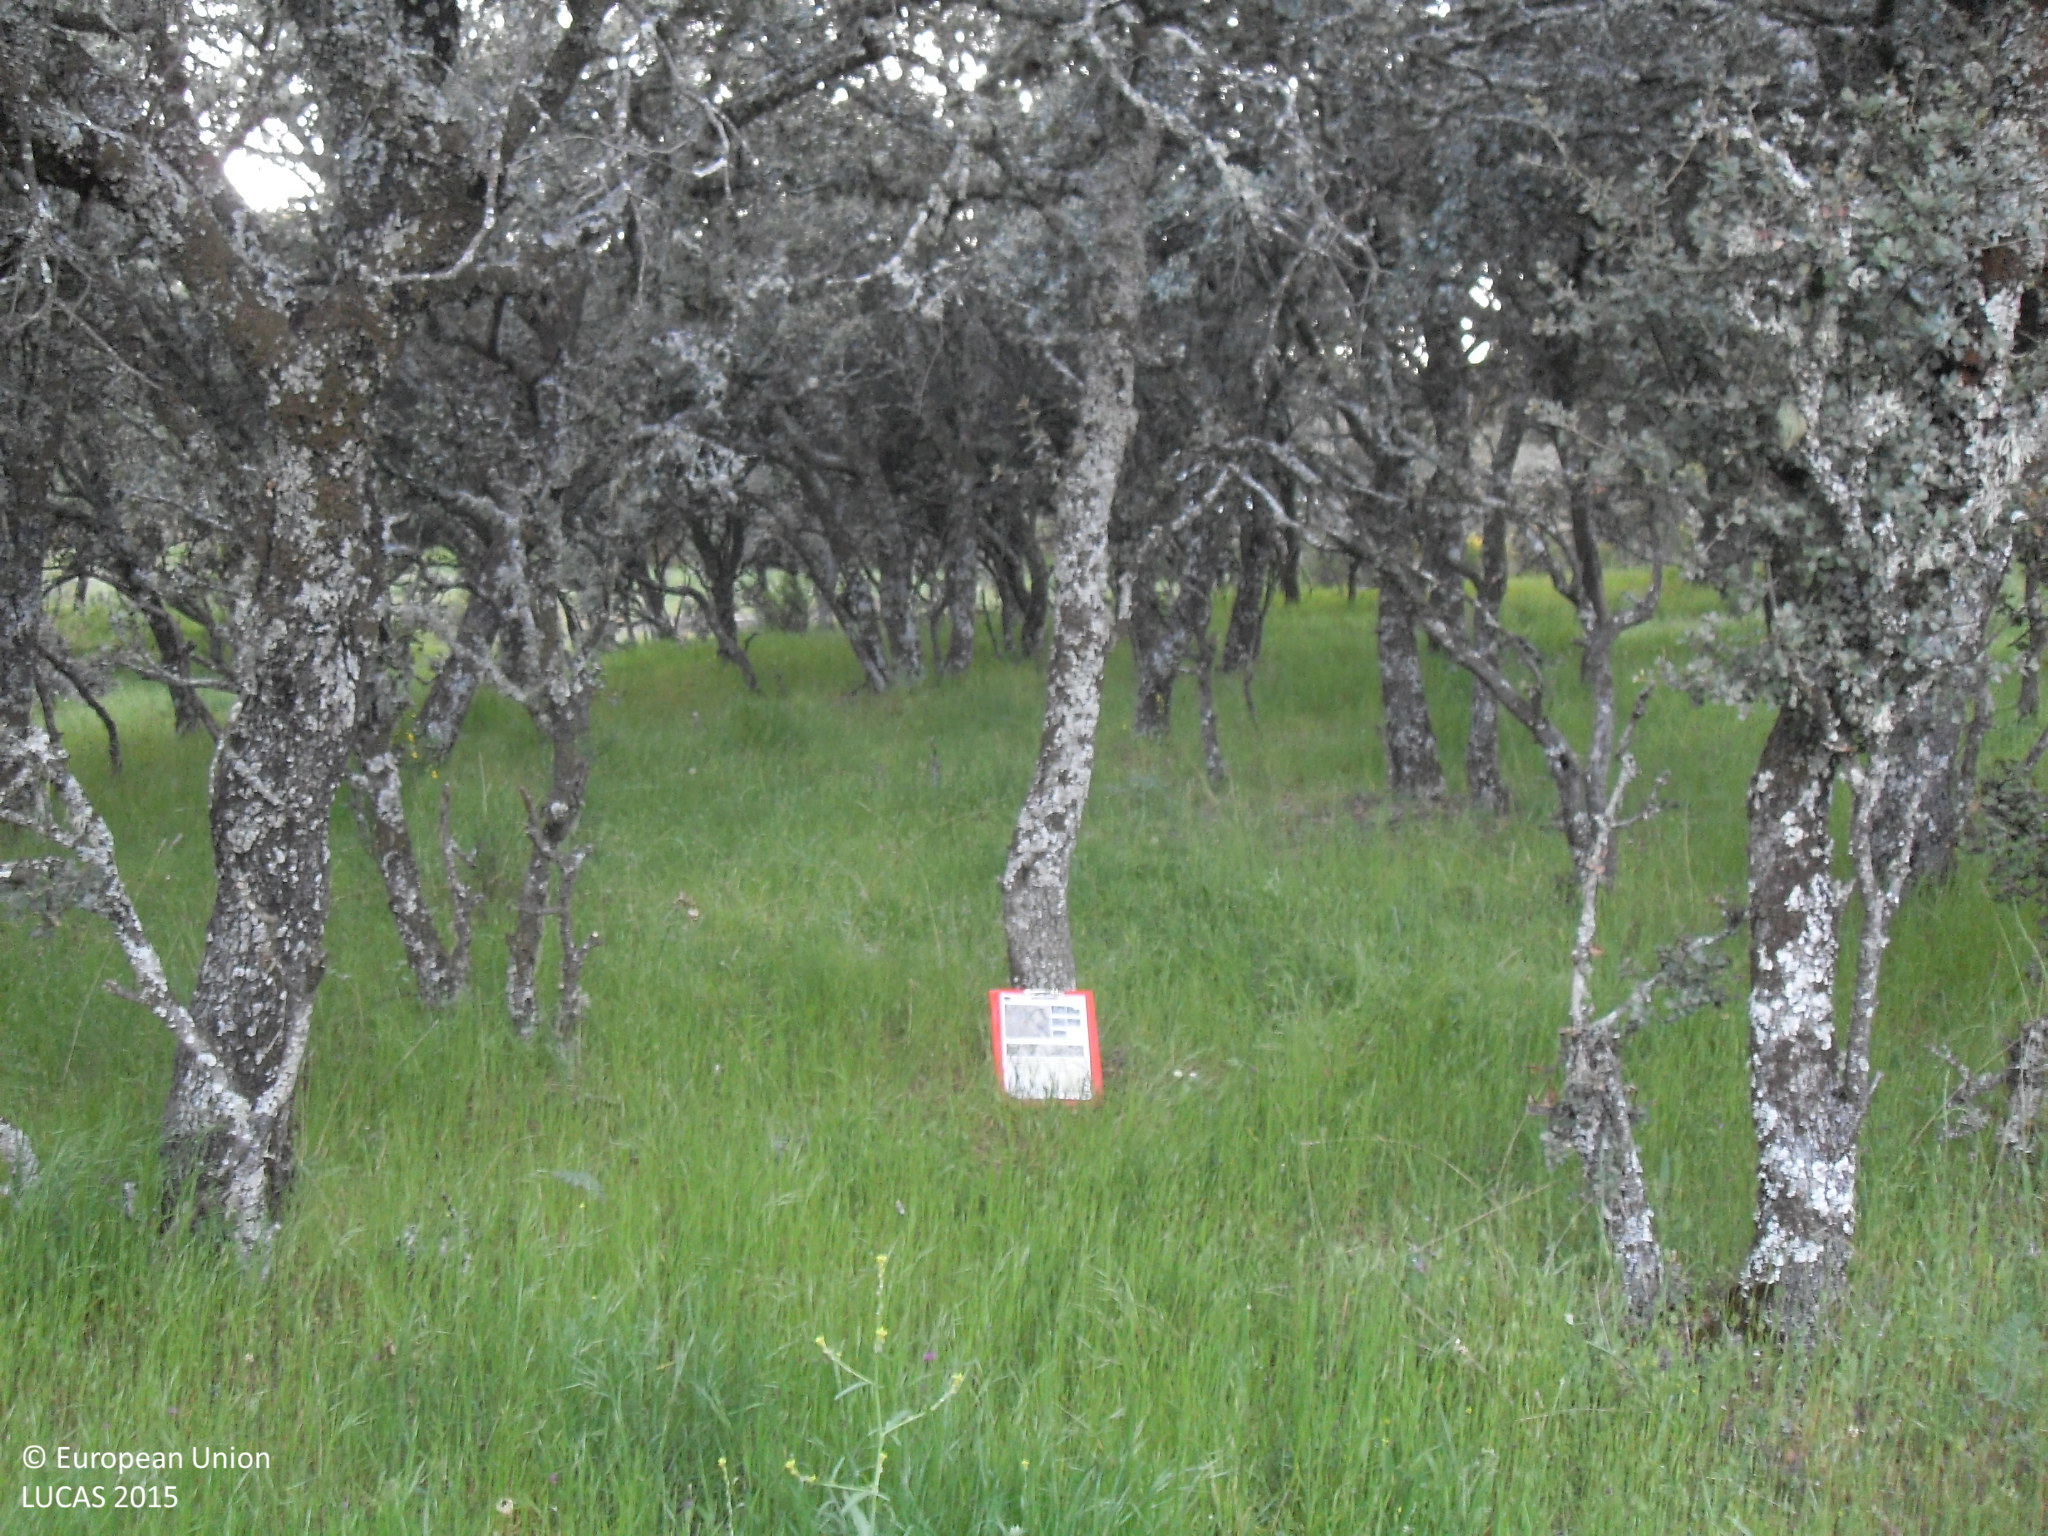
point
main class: Woodland
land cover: Broadleaved woodland
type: broadleaved evergreen forest
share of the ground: > 75 %
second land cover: Grassland without tree/shrub cover
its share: 10 - 25 %
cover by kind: broadleaved forest trees 60 %, herbaceous plants 40 %
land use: Forestry
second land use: Agriculture (excluding fallow land and kitchen gardens)
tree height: > 5 m
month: May
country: ES
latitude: 40.5216
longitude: -5.2303
